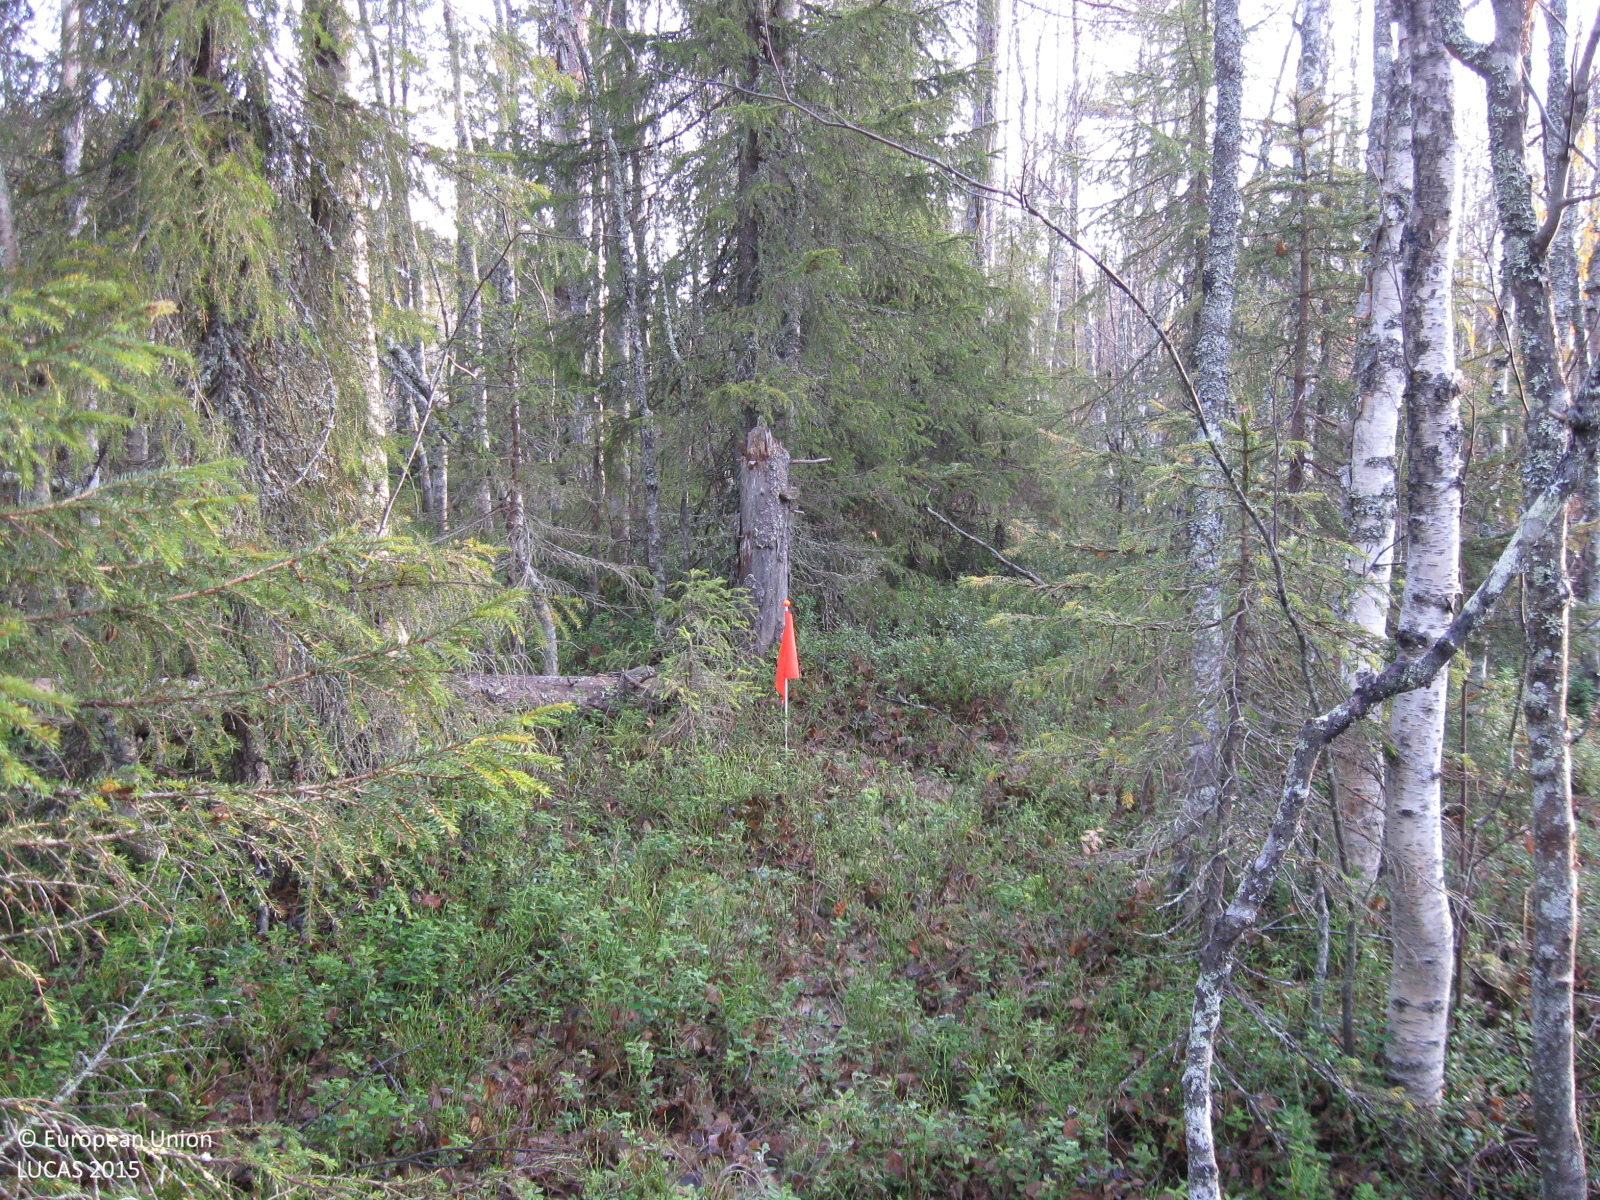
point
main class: Woodland
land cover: Spruce dominated mixed woodland
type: boreal forest
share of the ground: > 75 %
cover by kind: broadleaved forest trees 65 %, coniferous forest trees 25 %, shrubs 5 %, herbaceous plants 5 %
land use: Forestry
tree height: > 5 m
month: October
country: SE
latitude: 66.3873
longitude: 21.6212
